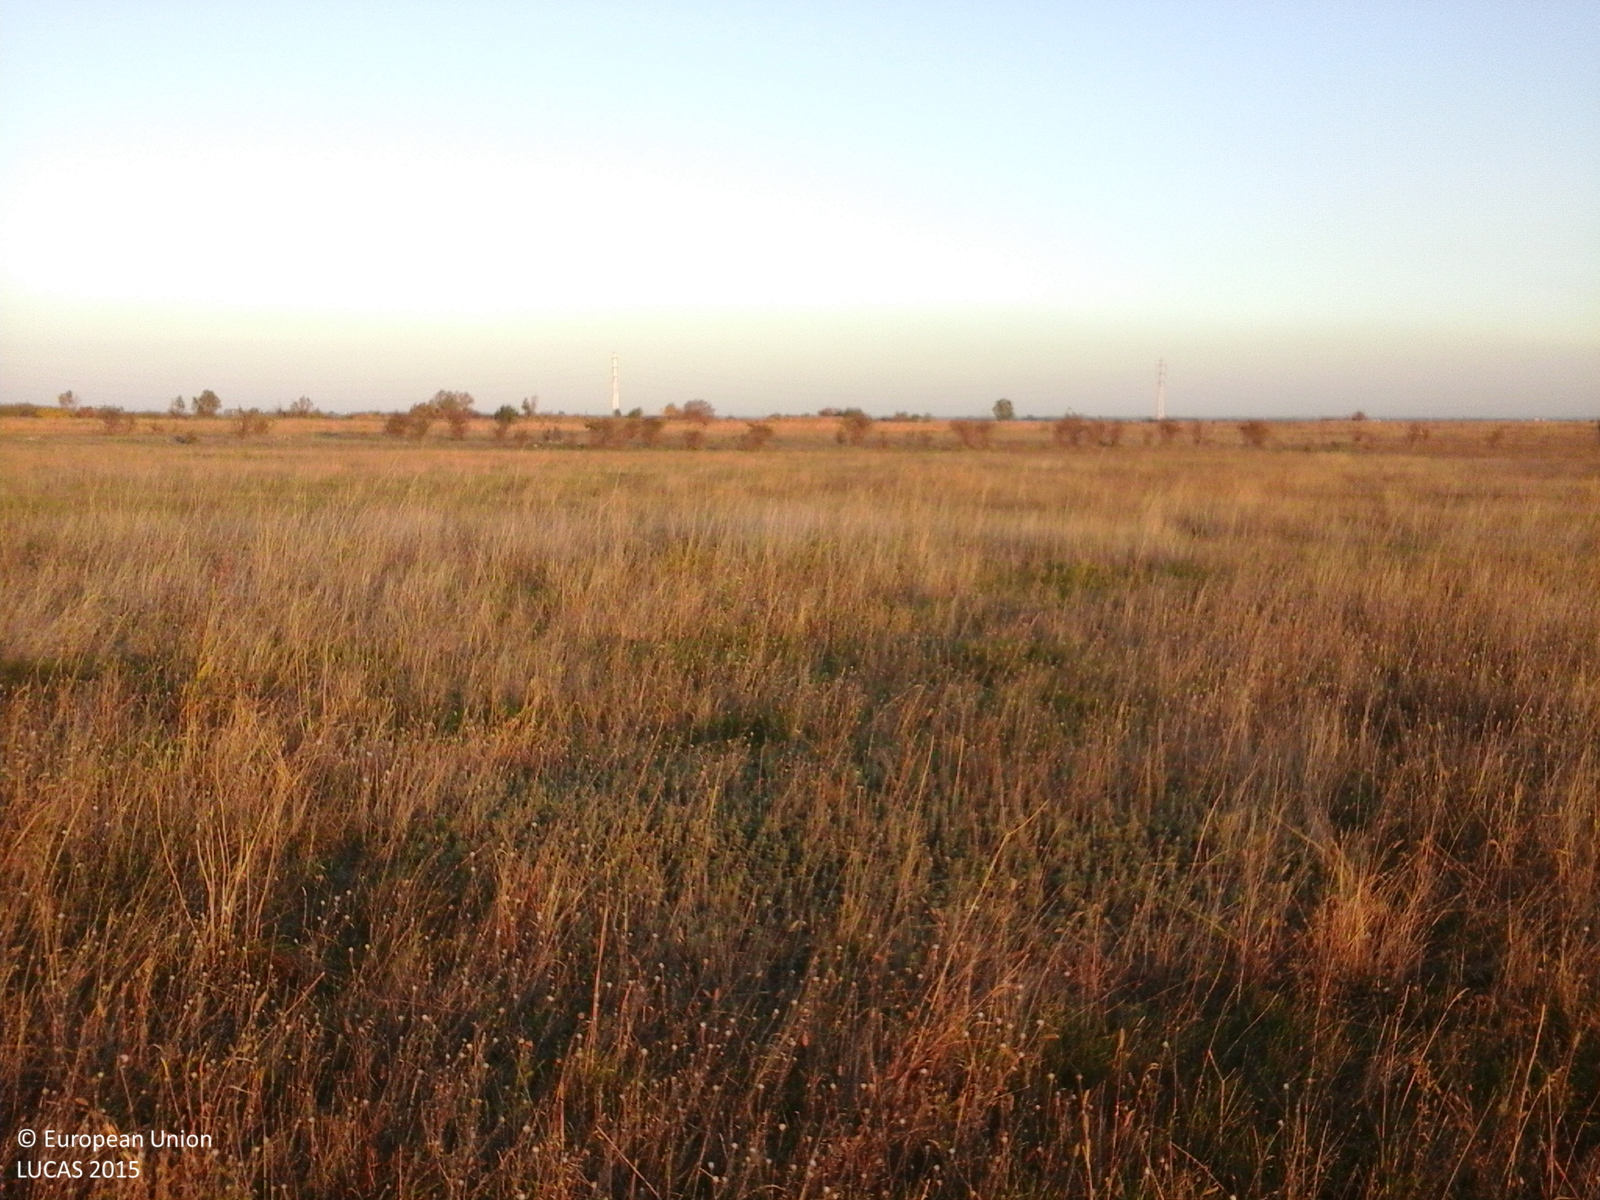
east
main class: Grassland
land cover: Grassland without tree/shrub cover
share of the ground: > 75 %
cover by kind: herbaceous plants 100 %
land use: Agriculture (excluding fallow land and kitchen gardens)
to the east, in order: Grassland without tree/shrub cover; Spontaneously vegetated surfaces; Grassland without tree/shrub cover; Tracks; Spontaneously vegetated surfaces
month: October
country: RO
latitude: 45.8003
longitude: 27.1422
